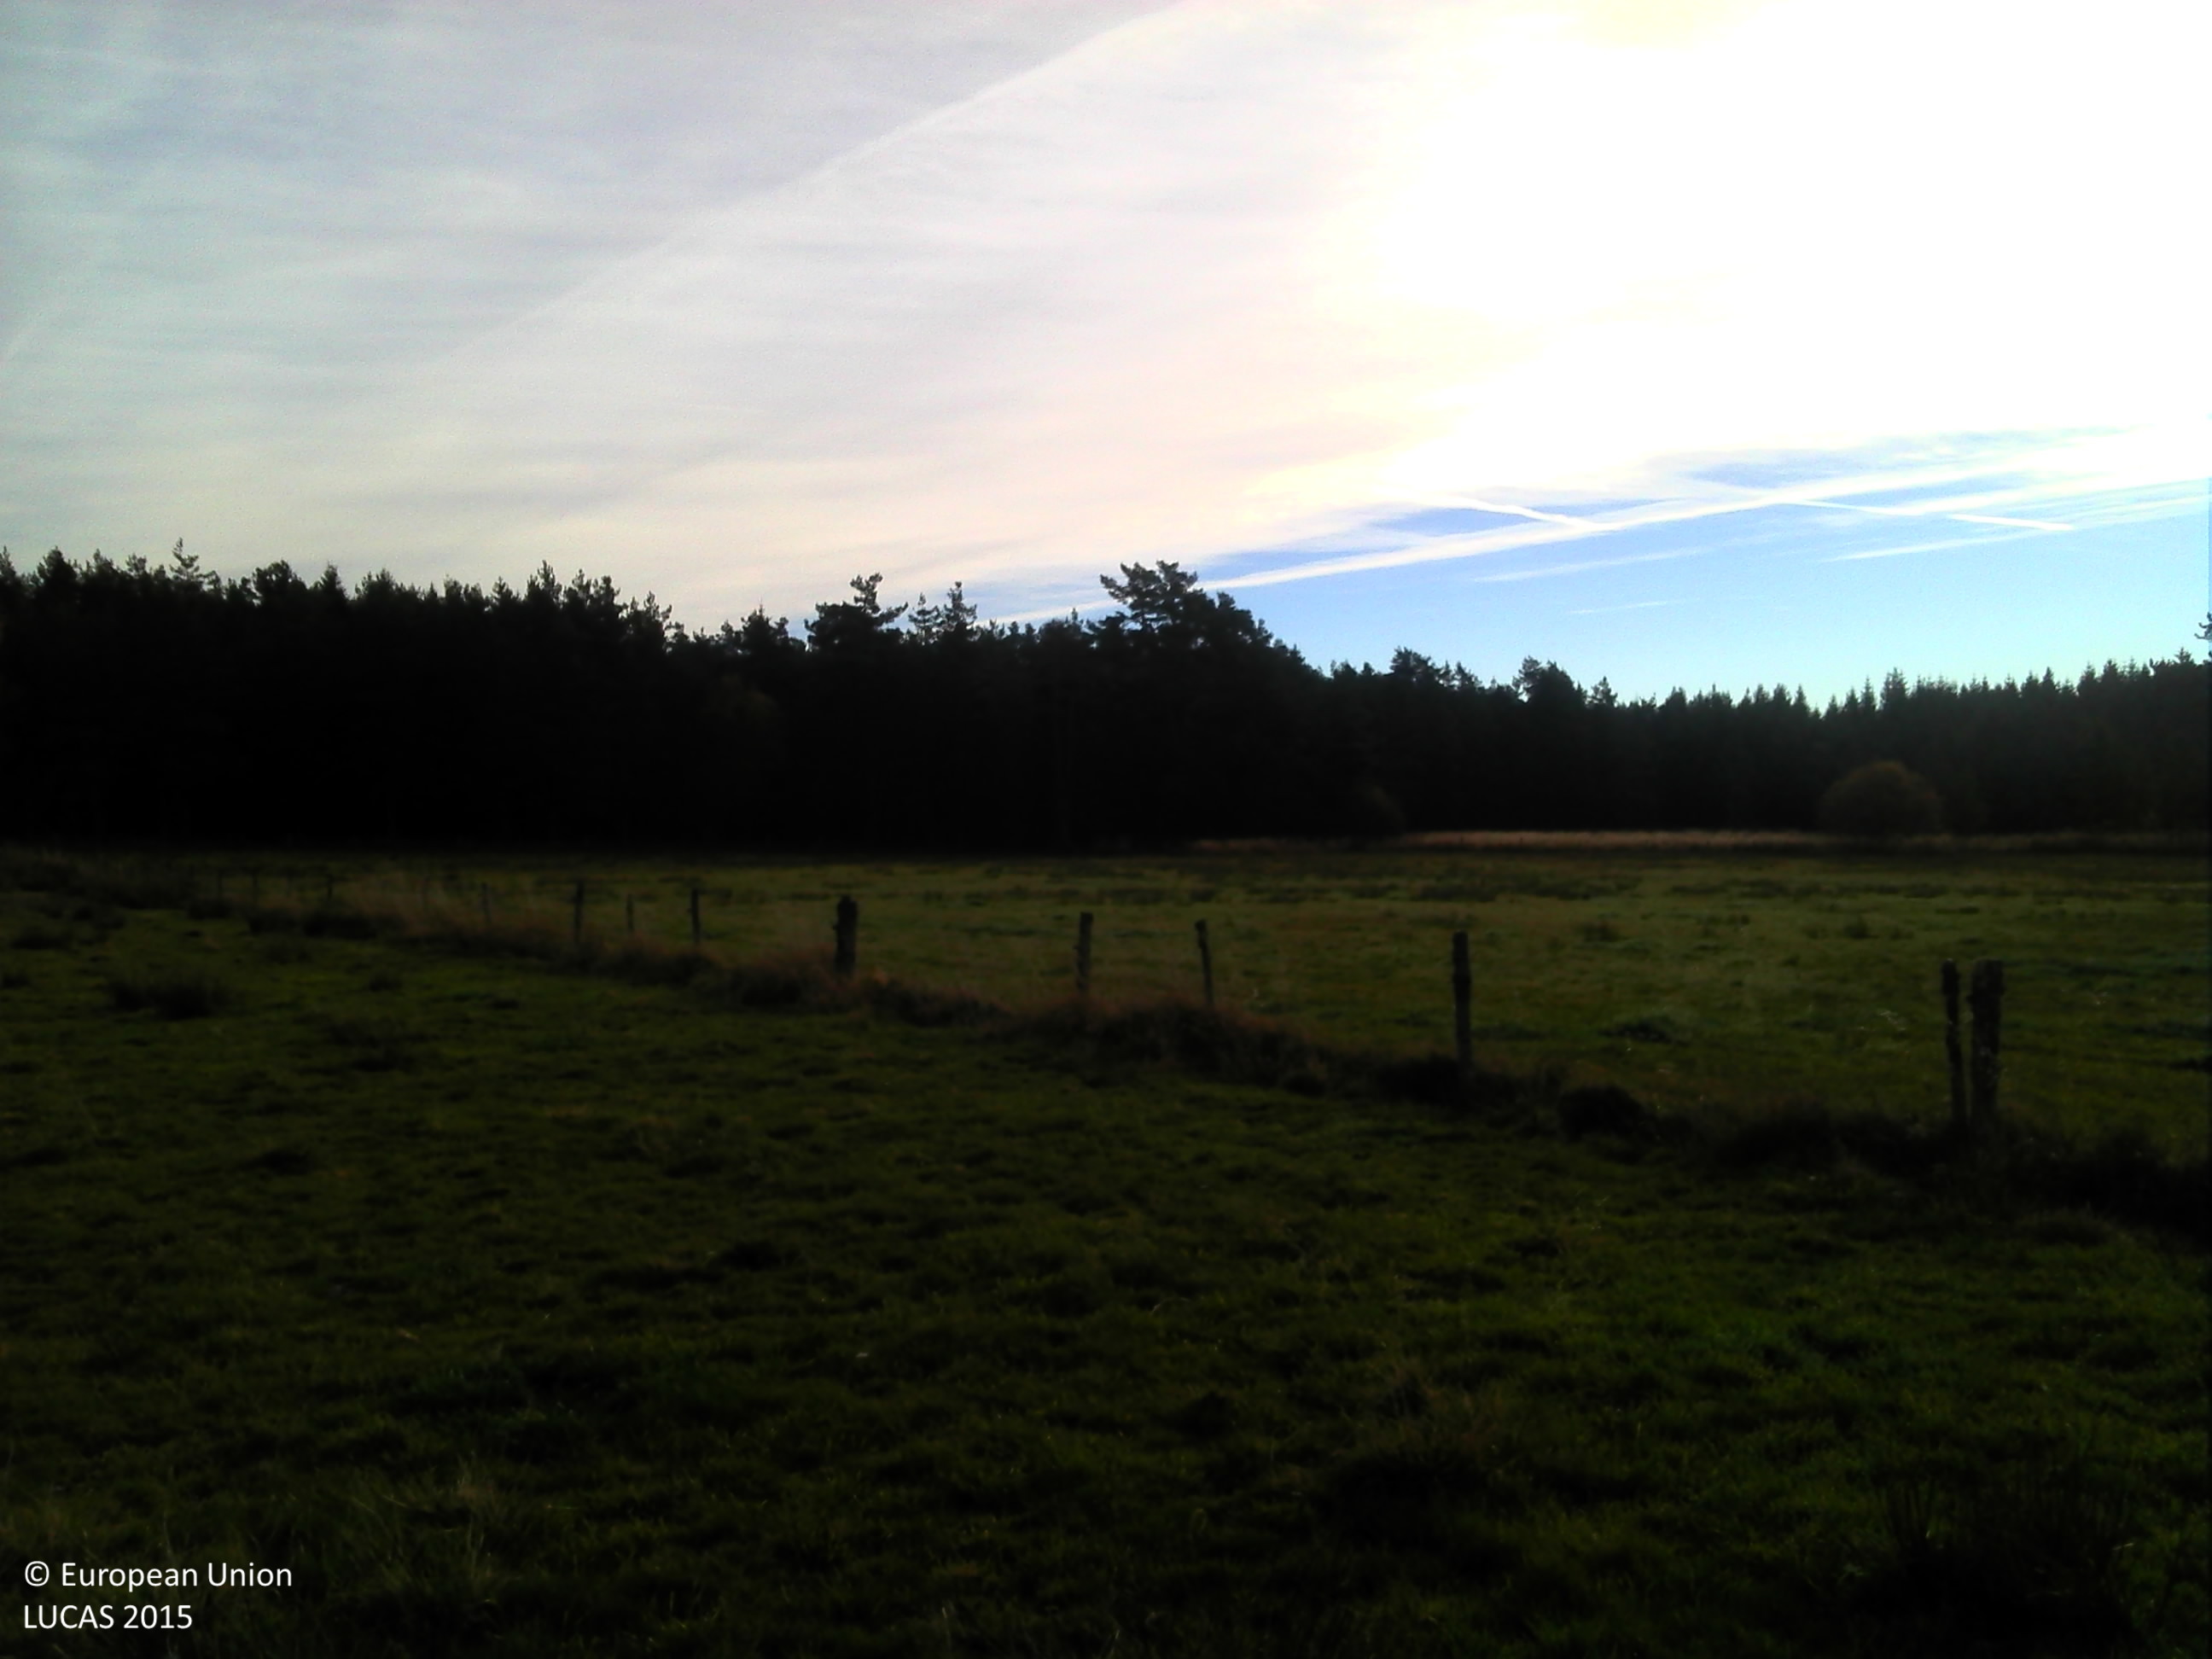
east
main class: Grassland
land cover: Grassland without tree/shrub cover
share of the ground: > 75 %
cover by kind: herbaceous plants 100 %
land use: Agriculture (excluding fallow land and kitchen gardens)
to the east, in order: Grassland without tree/shrub cover; Ditches and canals; Fences; Grassland without tree/shrub cover; Ditches and canals; Grassland without tree/shrub cover; Fences; Pine dominated coniferous woodland
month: November
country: FR
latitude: 45.3216
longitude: 3.7902
